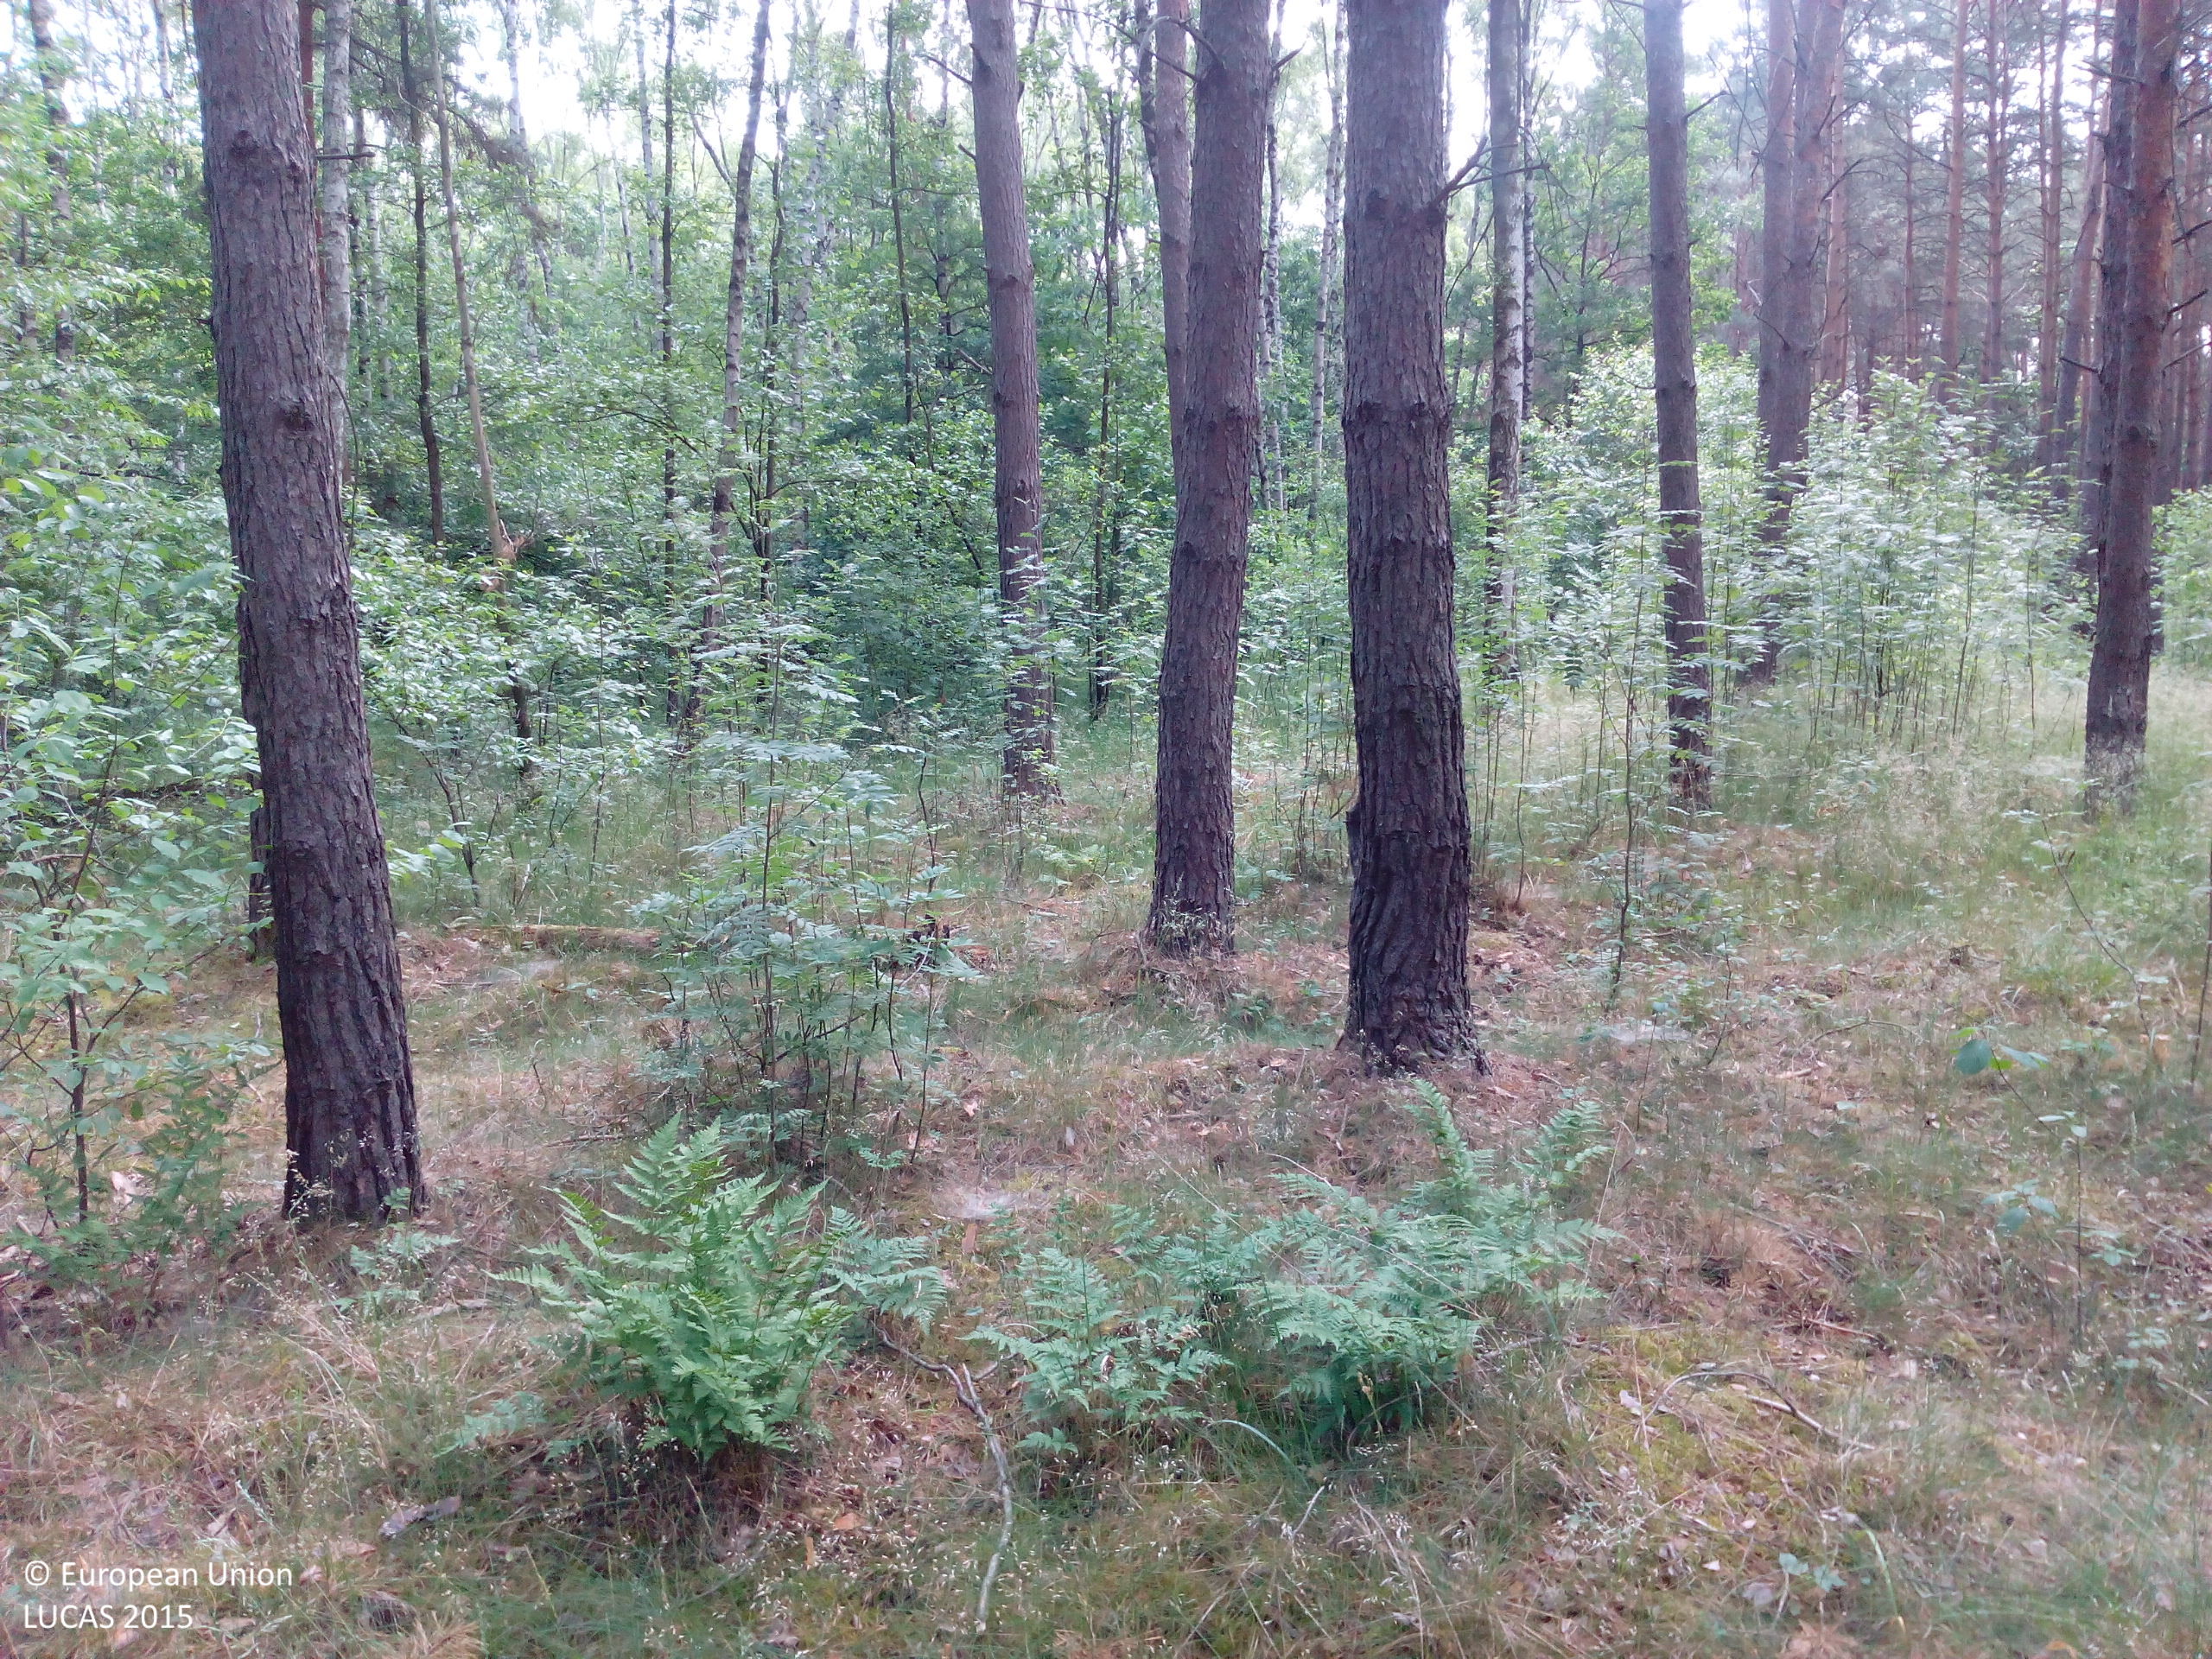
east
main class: Woodland
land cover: Pine dominated coniferous woodland
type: hemiboreal forest and nemoral coniferous forest and mixed broadleaved-coniferous forest
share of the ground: > 75 %
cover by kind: coniferous forest trees 80 %, broadleaved forest trees 15 %, shrubs 5 %
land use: Forestry
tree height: > 5 m
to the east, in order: Pine dominated coniferous woodland; Tracks; Pine dominated coniferous woodland
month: June
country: DE
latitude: 51.5408
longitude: 12.5518
